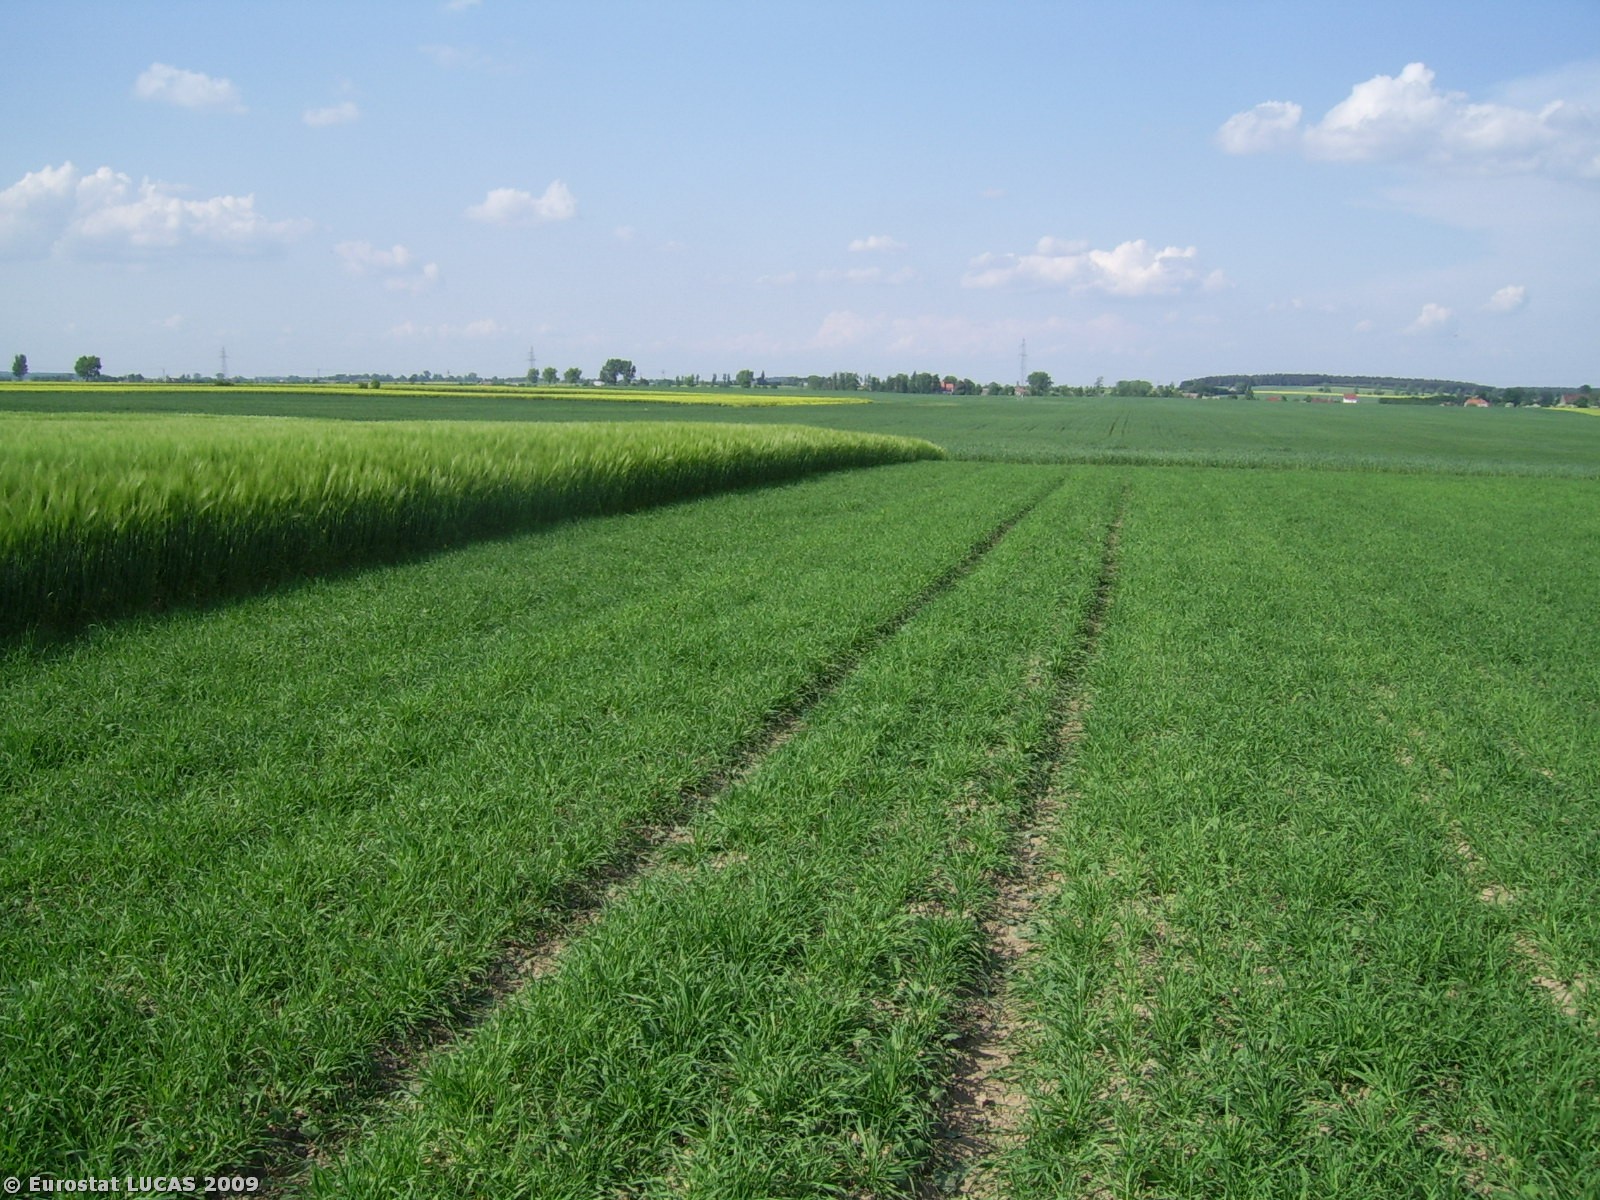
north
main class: Cropland
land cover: Barley
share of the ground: > 75 %
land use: Agriculture (excluding fallow land and kitchen gardens)
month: May
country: PL
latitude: 52.8897
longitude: 17.6376
